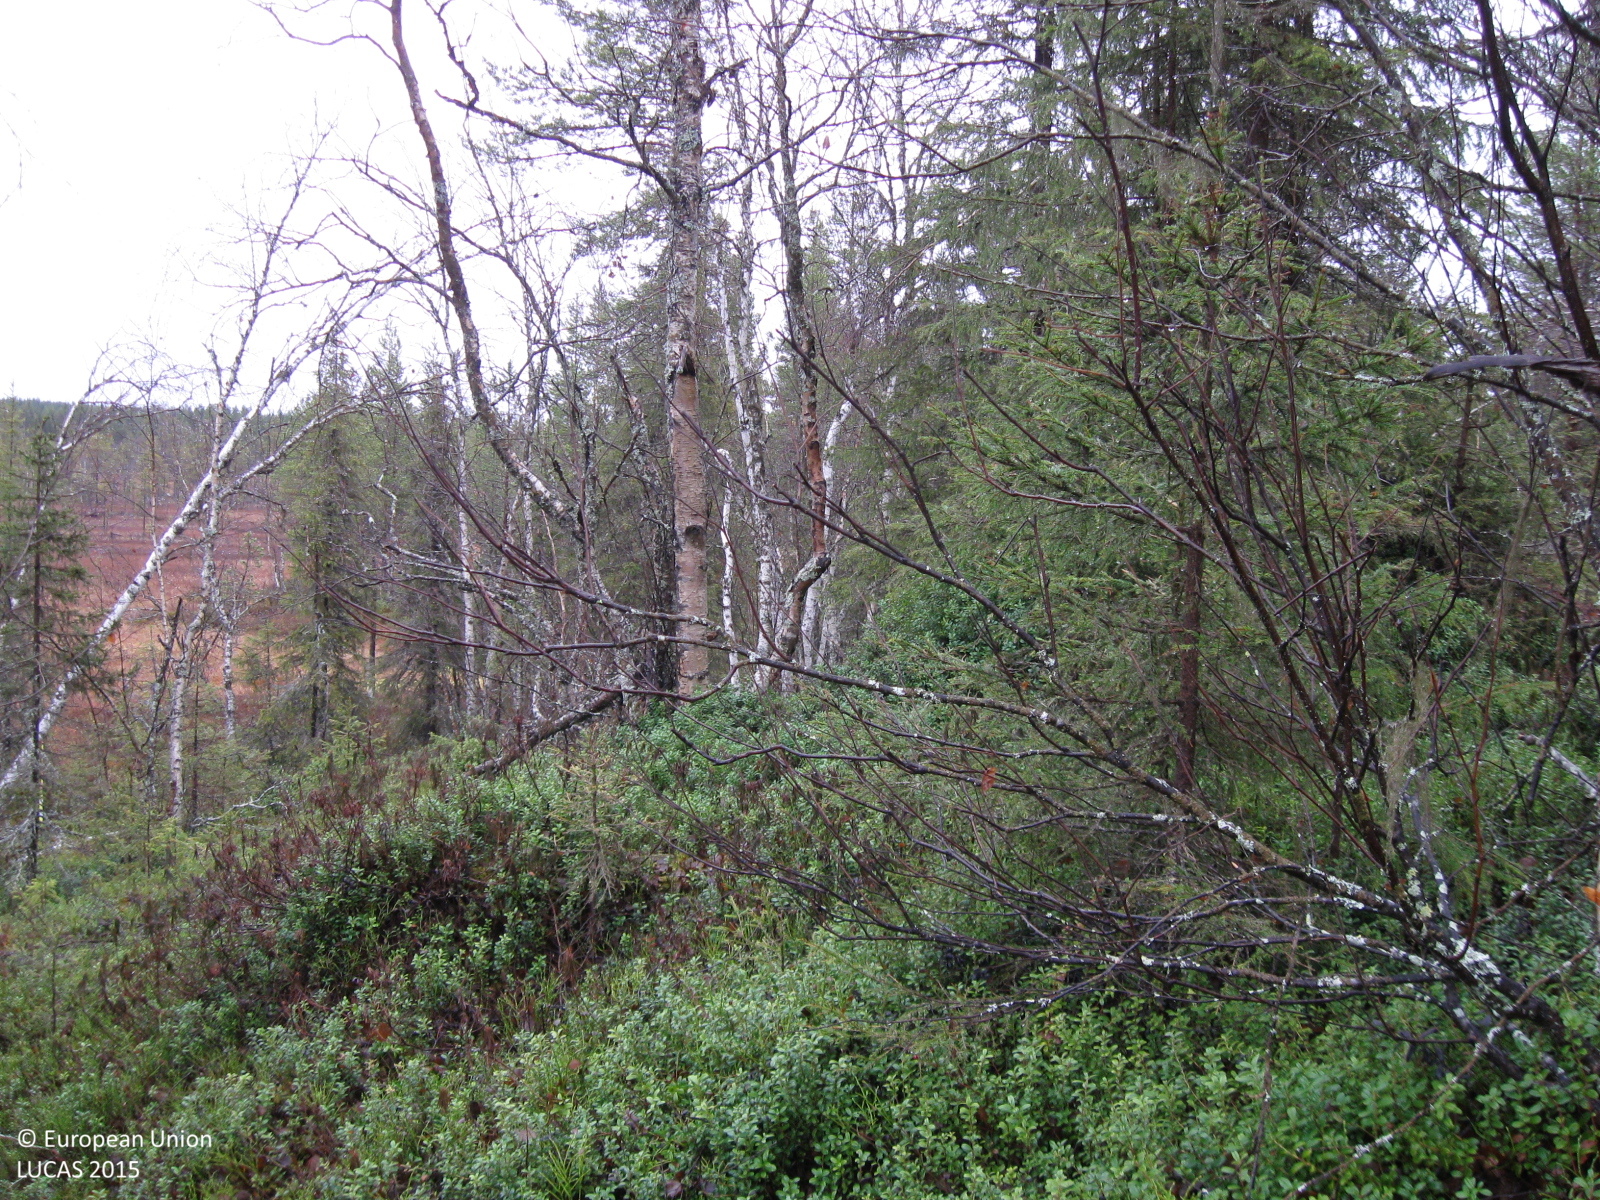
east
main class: Woodland
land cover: Spruce dominated mixed woodland
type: boreal forest
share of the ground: 50 - 75 %
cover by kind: shrubs 35 %, broadleaved forest trees 30 %, coniferous forest trees 20 %, herbaceous plants 10 %, lichens and mosses 5 %
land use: Forestry
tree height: > 5 m
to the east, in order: Spruce dominated mixed woodland; Peatbogs; Spruce dominated mixed woodland; Pine dominated coniferous woodland; Spruce dominated mixed woodland; Pine dominated coniferous woodland; Pine dominated mixed woodland; Inland fresh water bodies
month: October
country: SE
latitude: 66.5410
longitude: 20.9662
